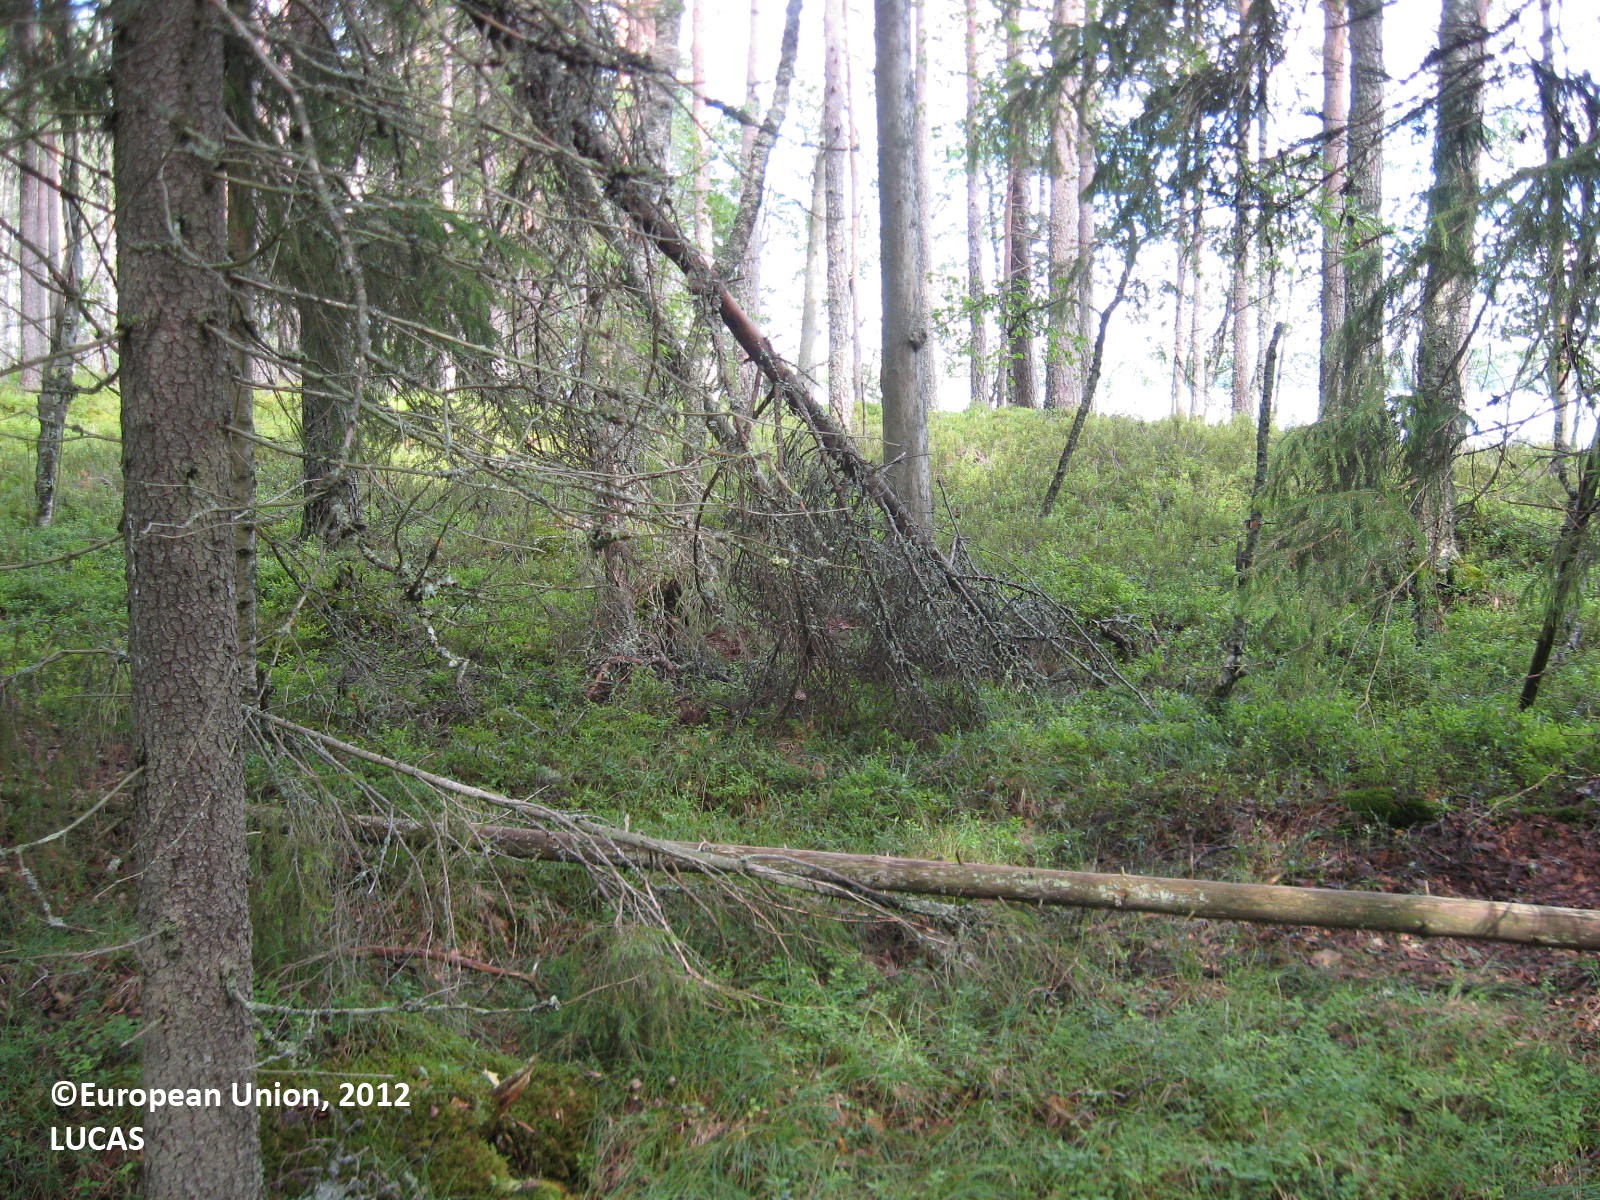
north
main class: Woodland
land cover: Other mixed woodland
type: boreal forest
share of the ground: > 75 %
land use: Forestry
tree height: > 5 m
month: July
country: FI
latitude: 62.0821
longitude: 22.7950
